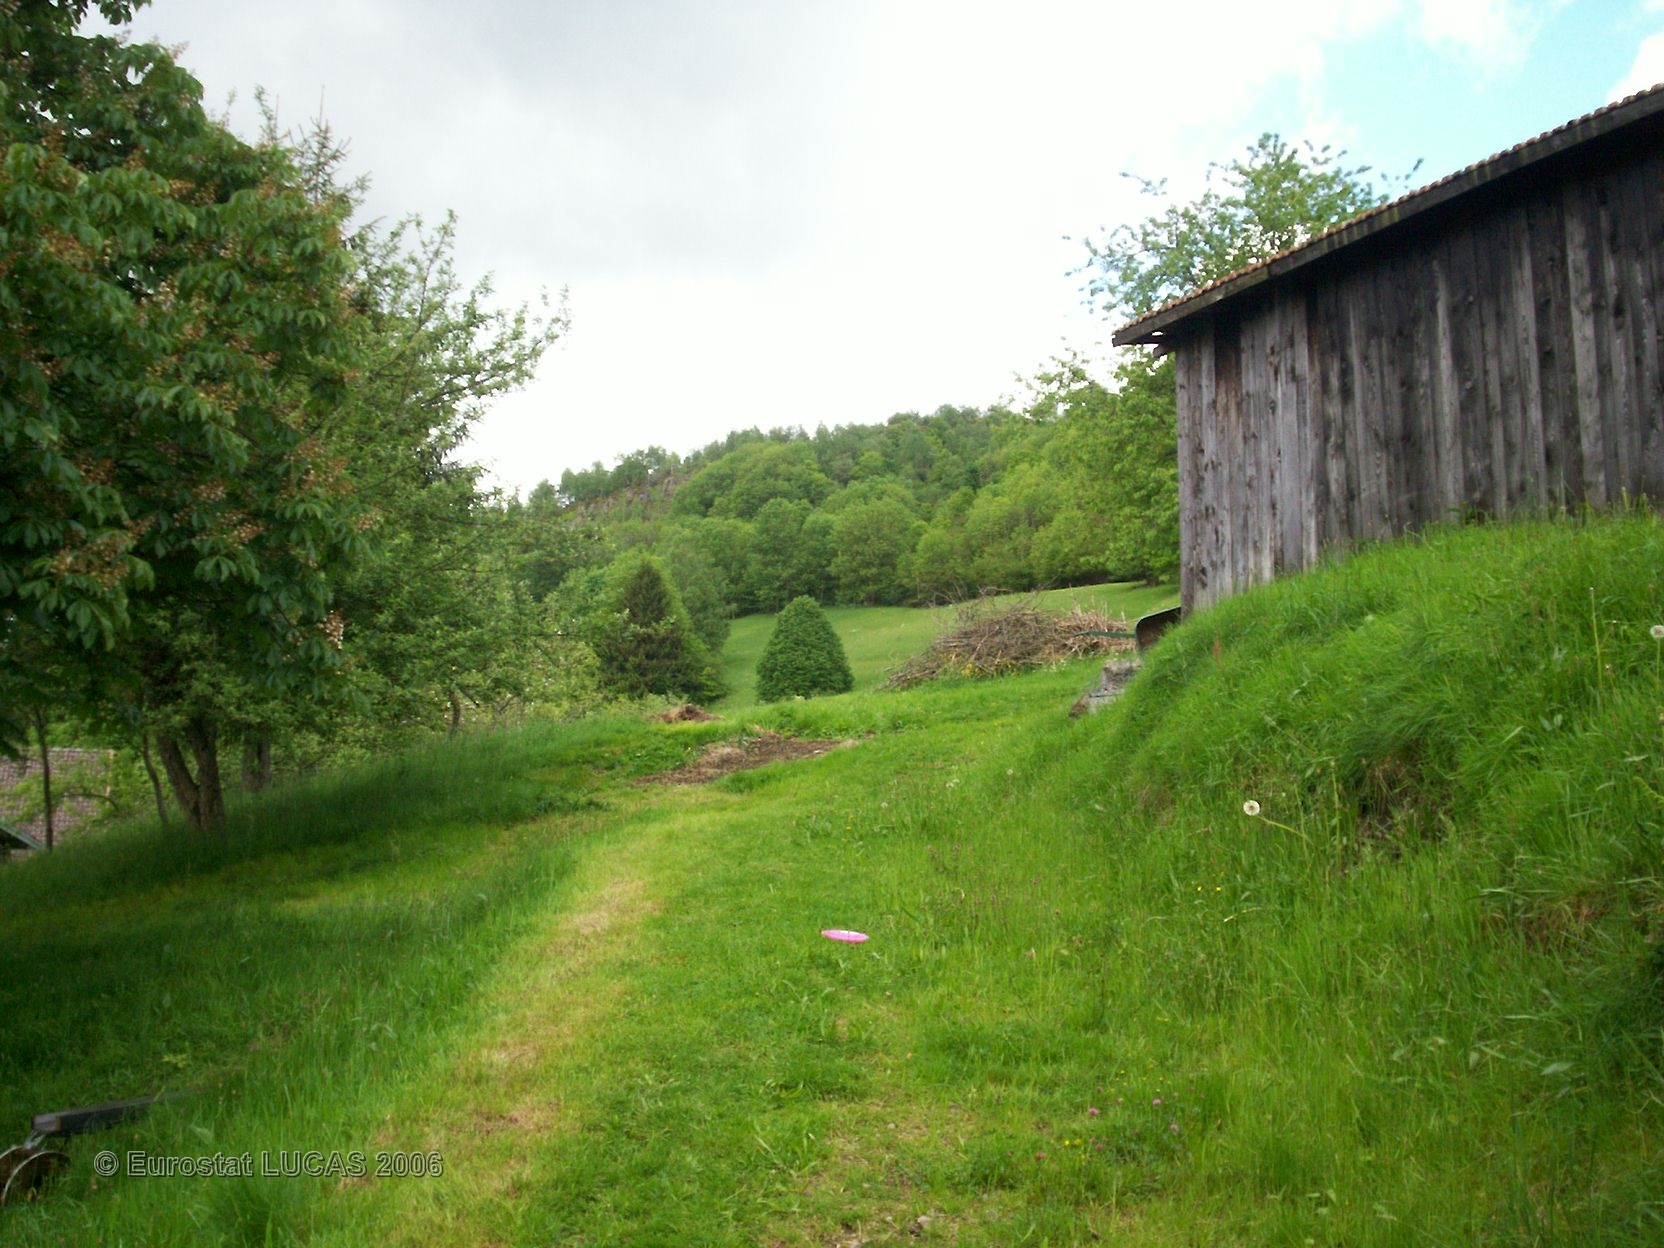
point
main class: Grassland
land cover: Grassland with sparse tree/shrub cover
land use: Agriculture (excluding fallow land and kitchen gardens)
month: June
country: FR
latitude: 47.8883
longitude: 6.7781
